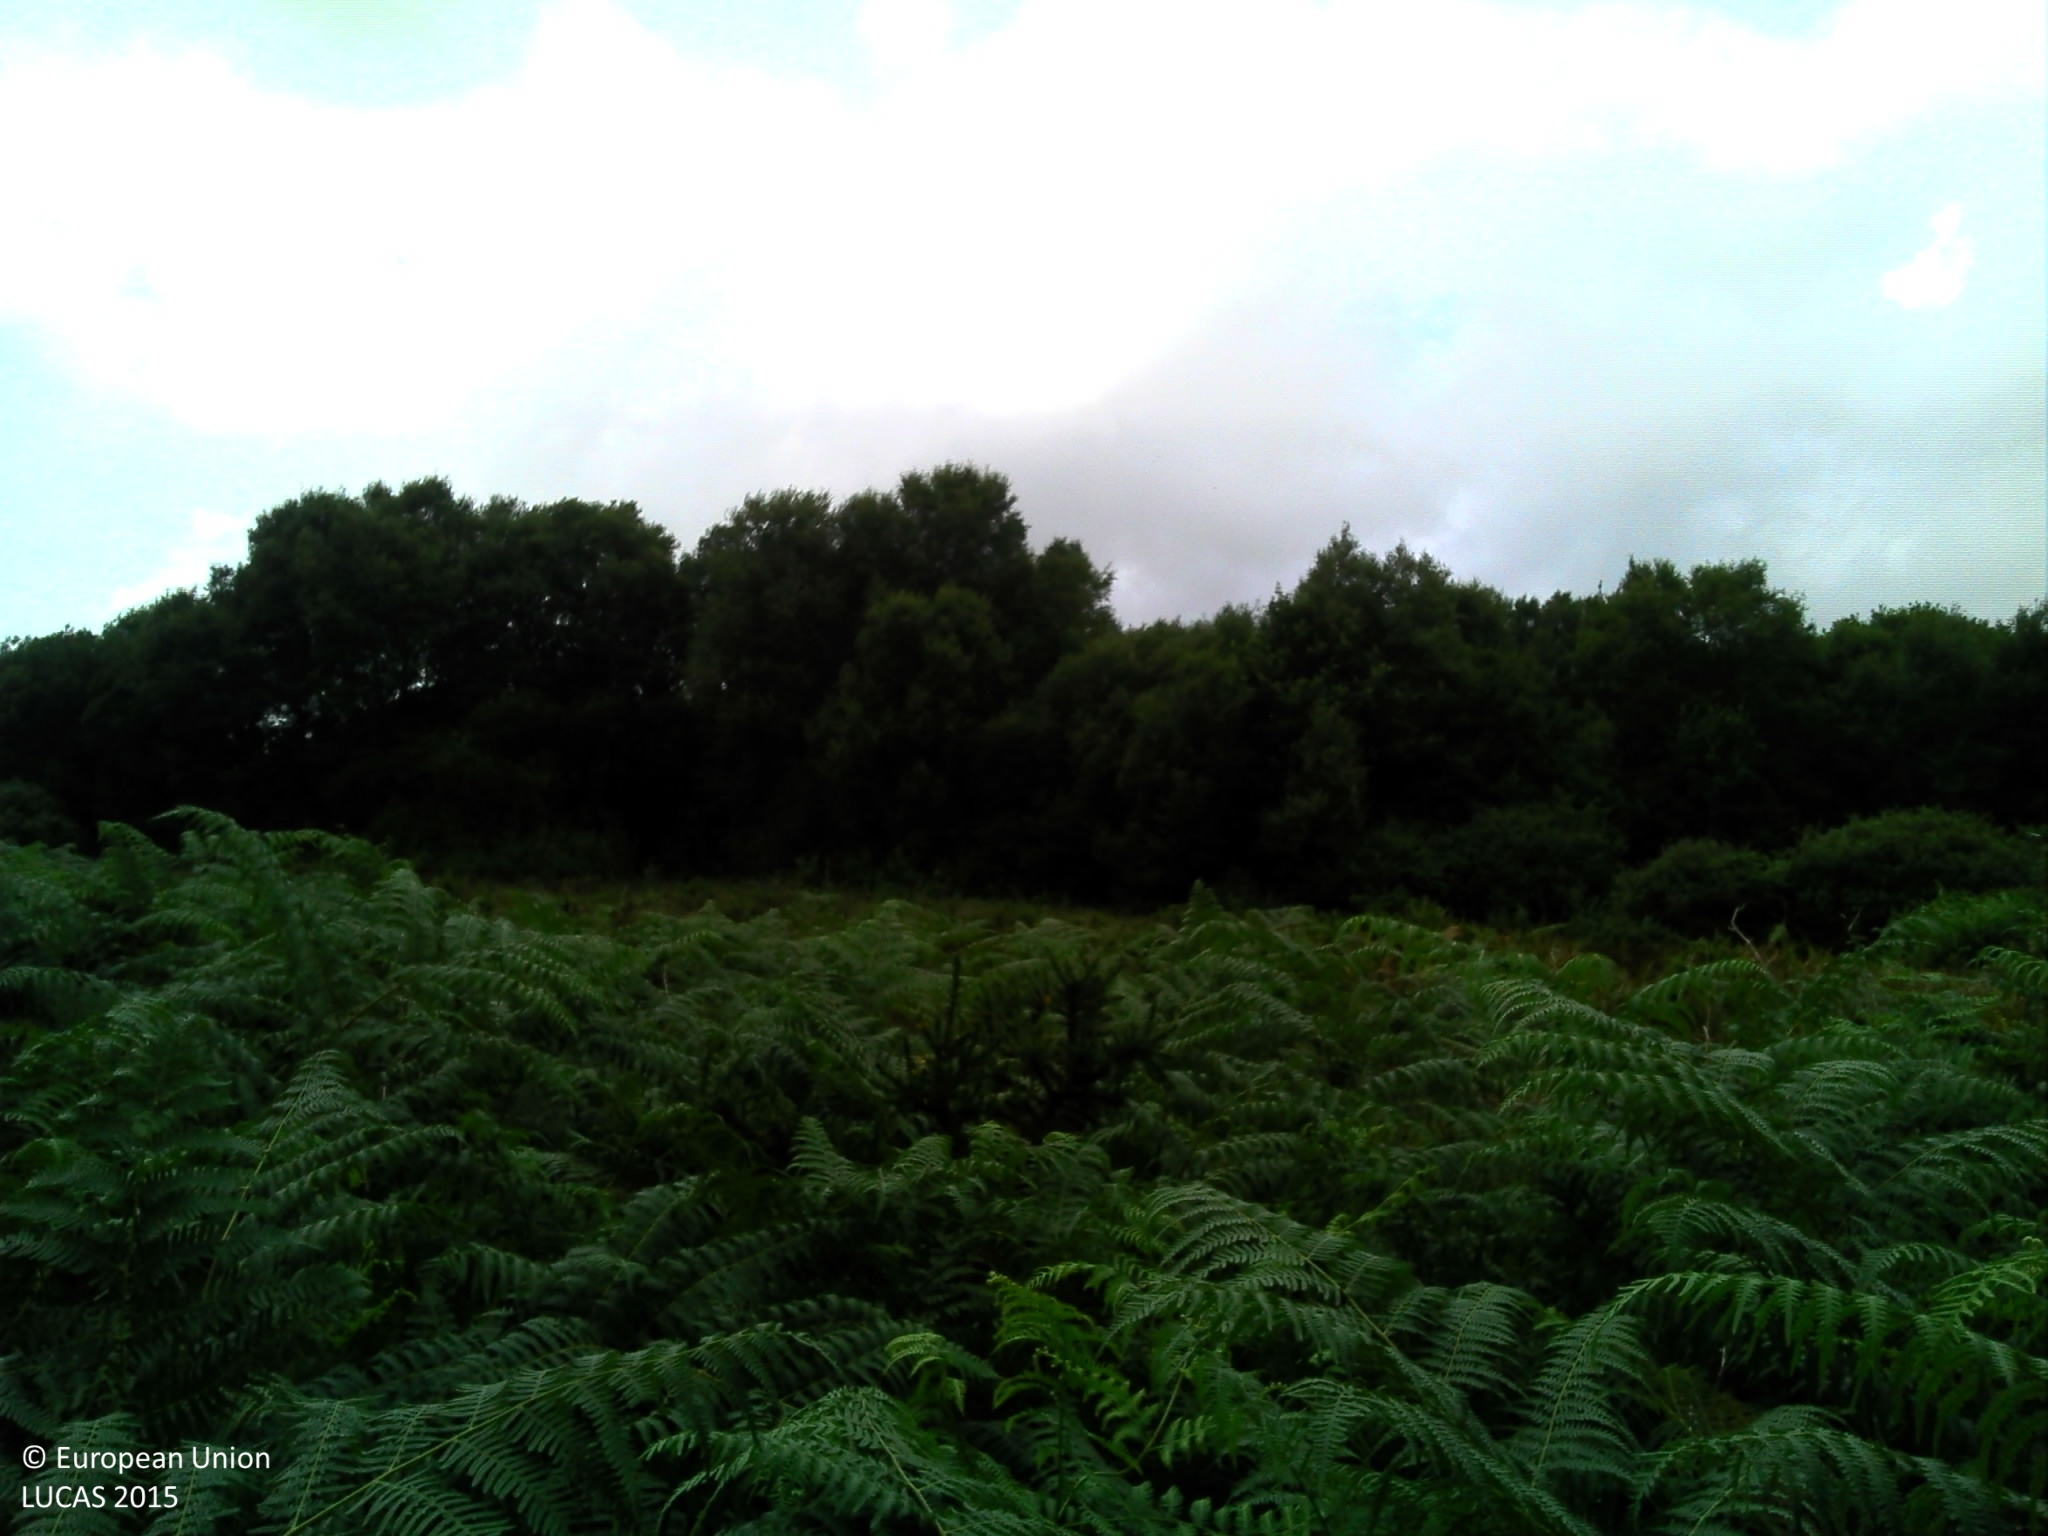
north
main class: Grassland
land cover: Spontaneously vegetated surfaces
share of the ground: > 75 %
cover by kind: herbaceous plants 95 %, shrubs 5 %
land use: Semi-natural and natural areas not in use
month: August
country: FR
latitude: 48.3644
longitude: -3.1239
